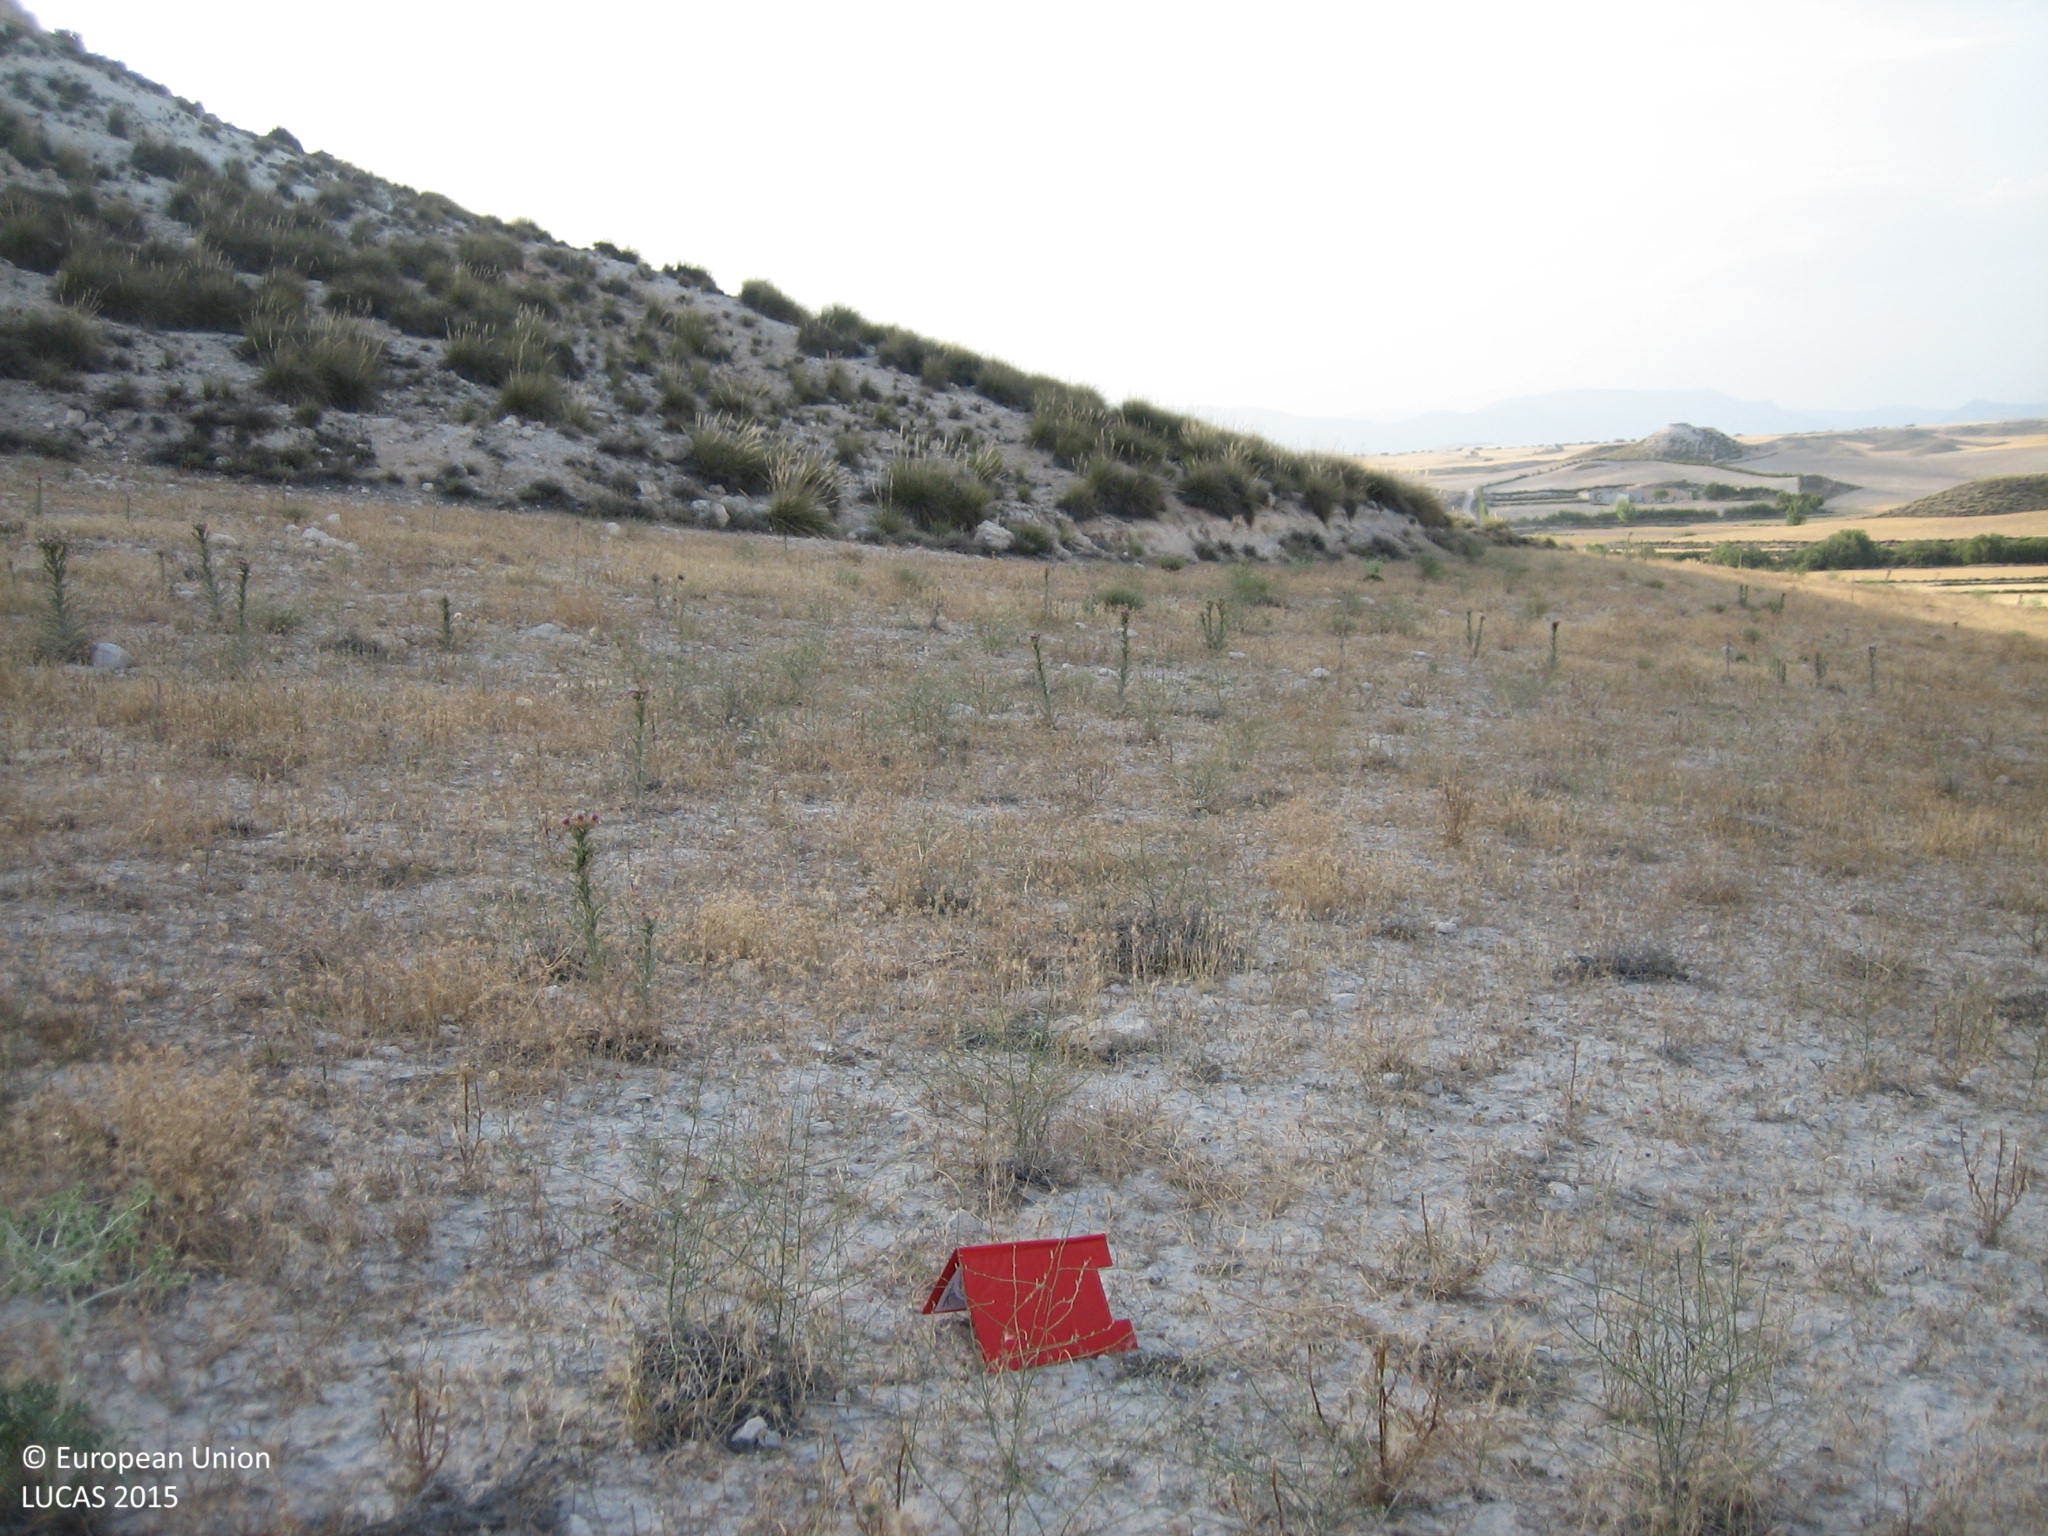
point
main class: Grassland
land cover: Spontaneously vegetated surfaces
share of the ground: 25 - 50 %
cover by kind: unconsolidated bare surface 70 %, herbaceous plants 30 %
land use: Fallow land
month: July
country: ES
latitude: 37.7370
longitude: -2.4135
